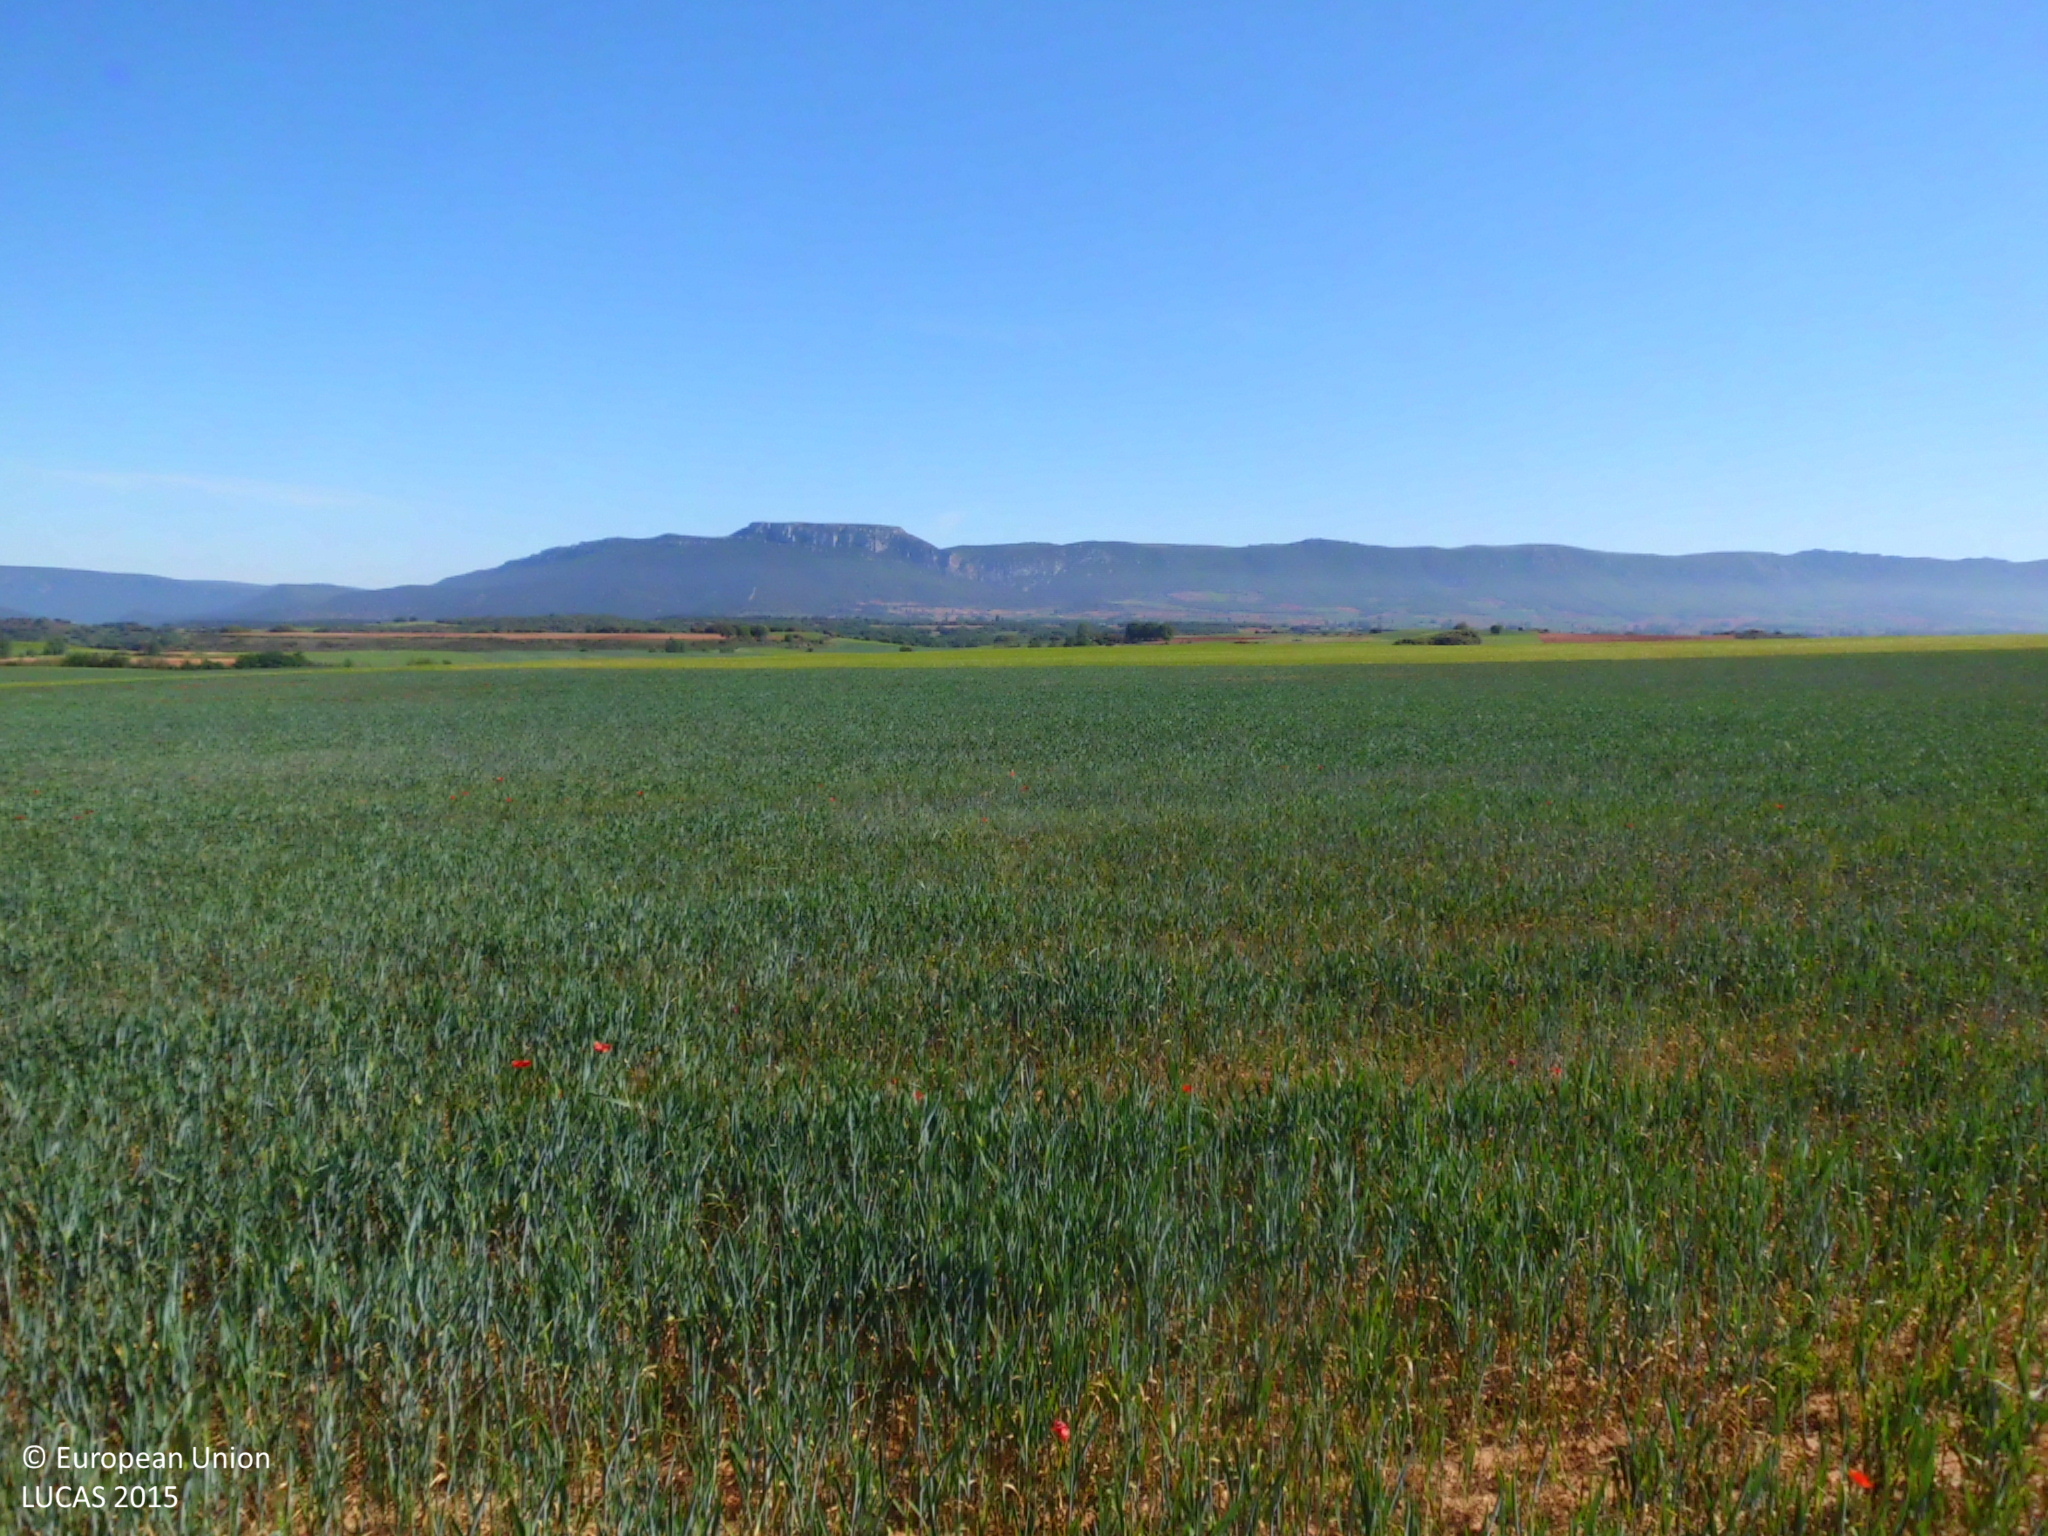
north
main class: Cropland
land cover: Common wheat
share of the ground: 25 - 50 %
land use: Agriculture (excluding fallow land and kitchen gardens)
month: May
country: ES
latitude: 42.6349
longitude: -3.4126
